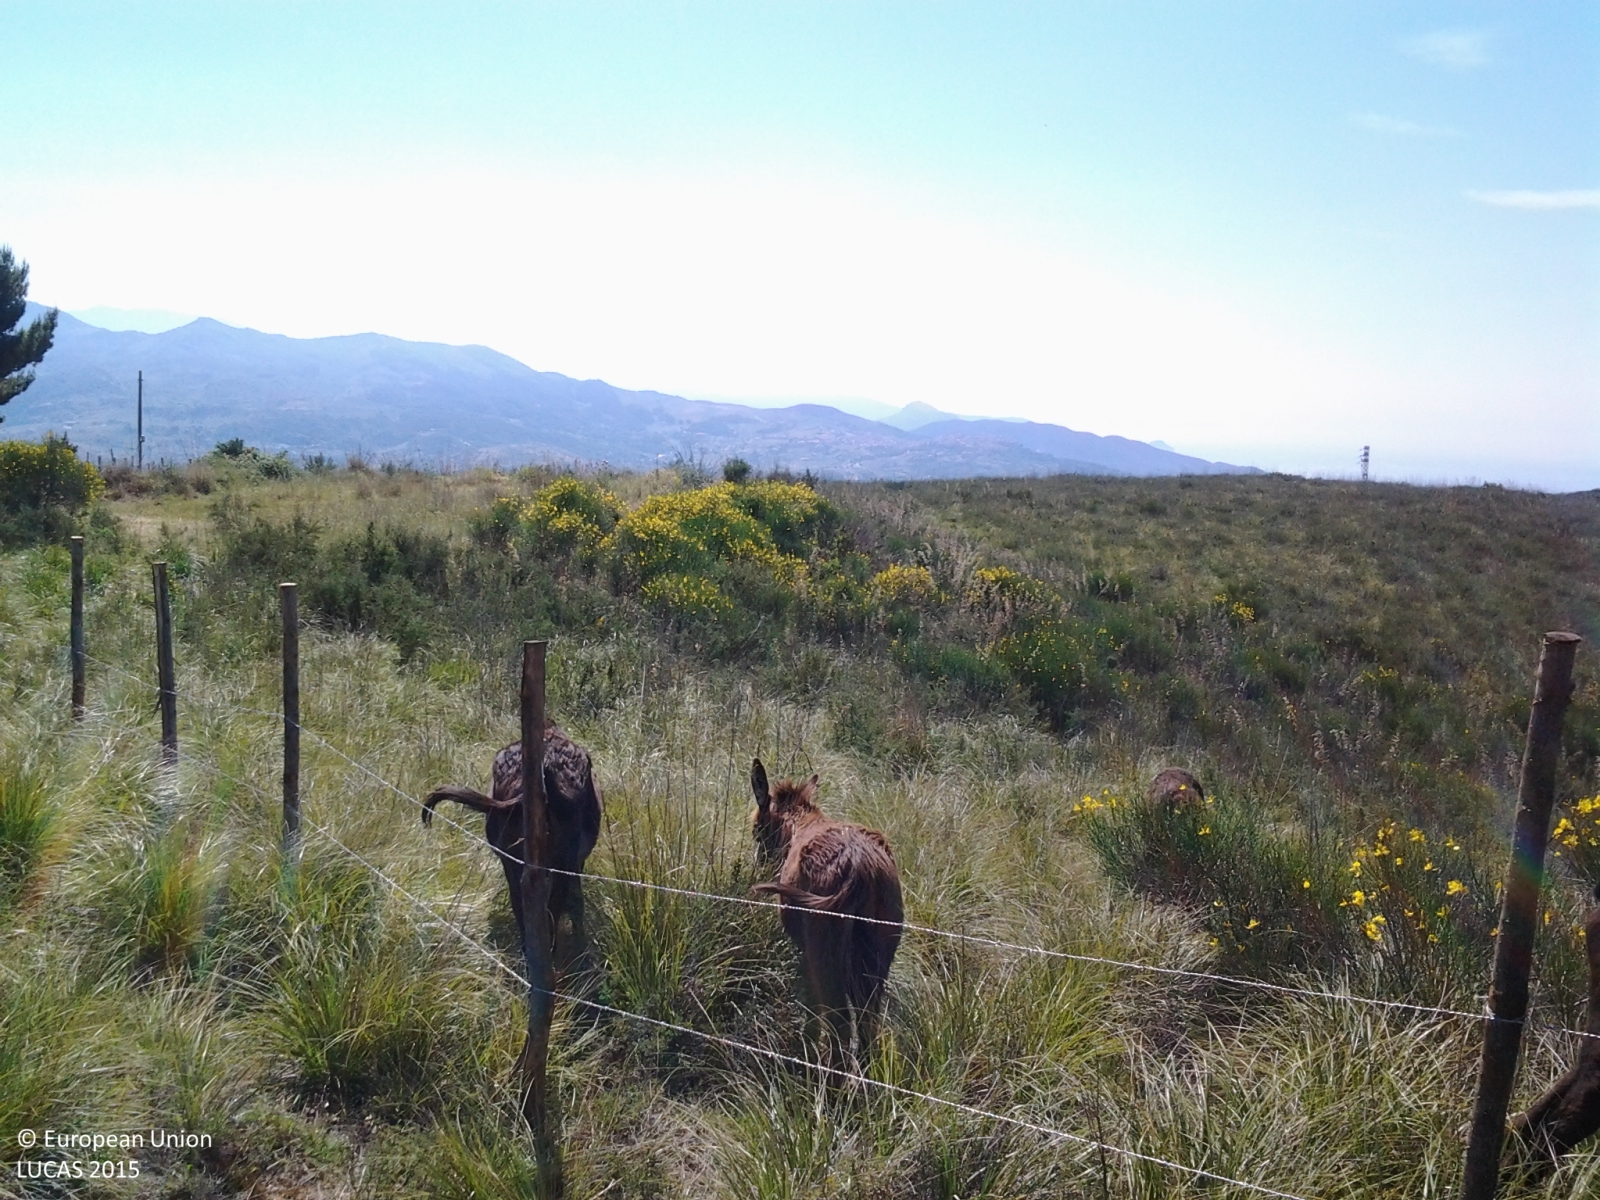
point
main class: Shrubland
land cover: Shrubland without tree cover
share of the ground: > 75 %
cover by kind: shrubs 55 %, herbaceous plants 40 %, consolidated bare surface 5 %
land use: Agriculture (excluding fallow land and kitchen gardens)
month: June
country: IT
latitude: 37.9770
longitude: 14.3077
